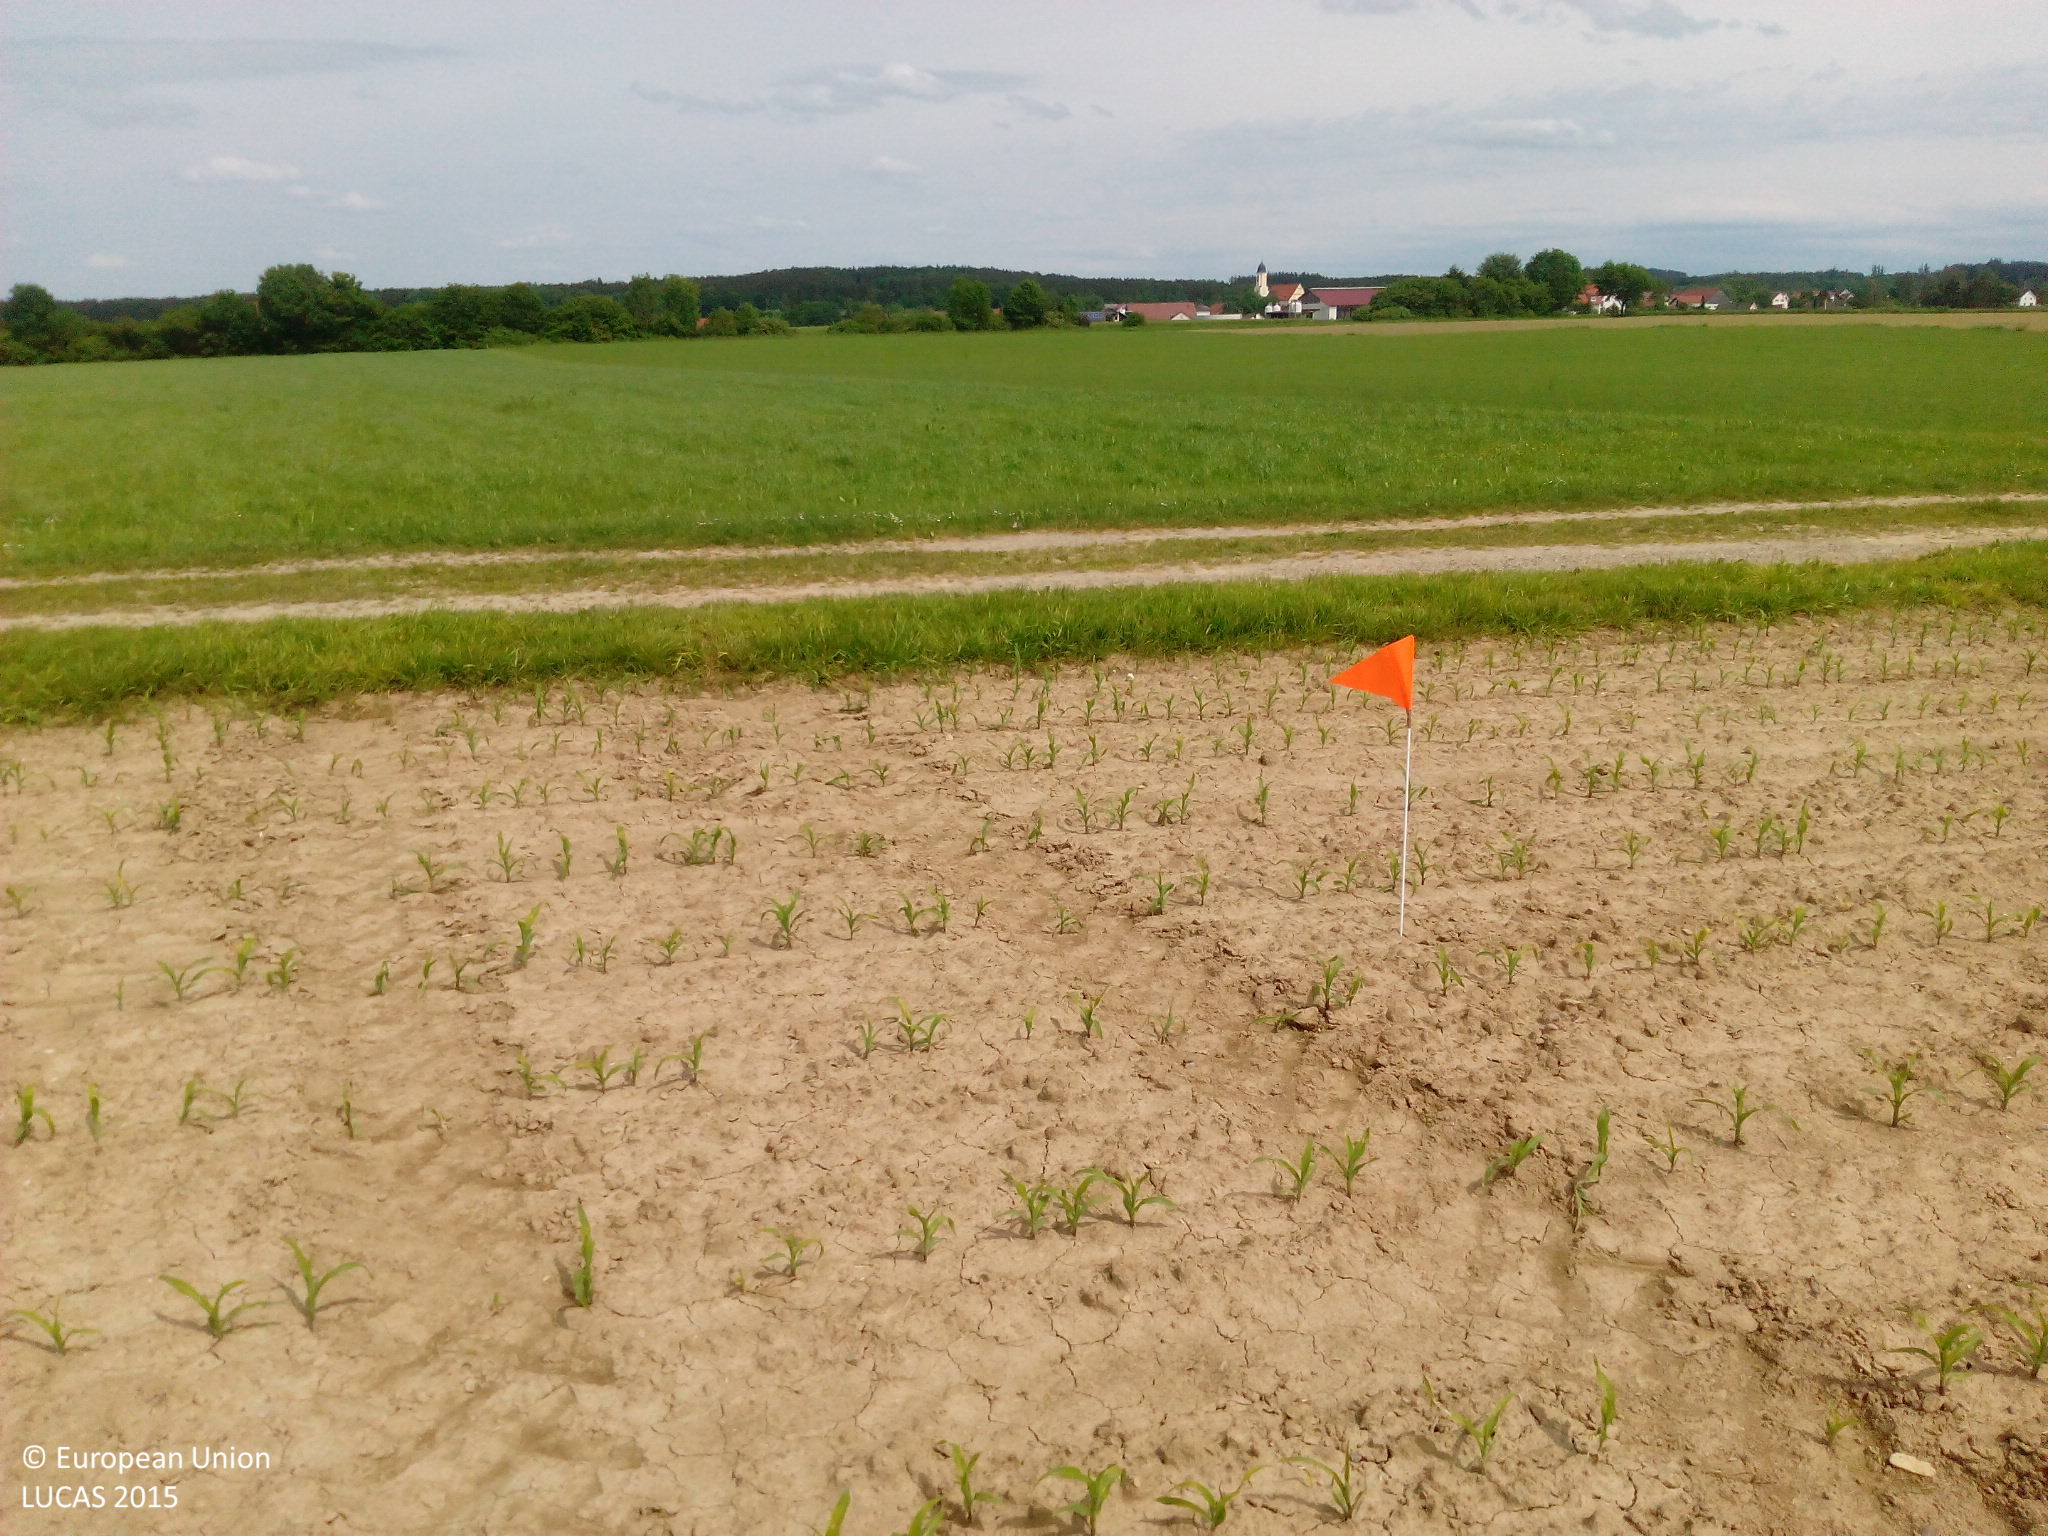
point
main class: Cropland
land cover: Maize
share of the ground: < 10 %
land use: Agriculture (excluding fallow land and kitchen gardens)
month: May
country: DE
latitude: 48.0073
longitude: 10.2545
